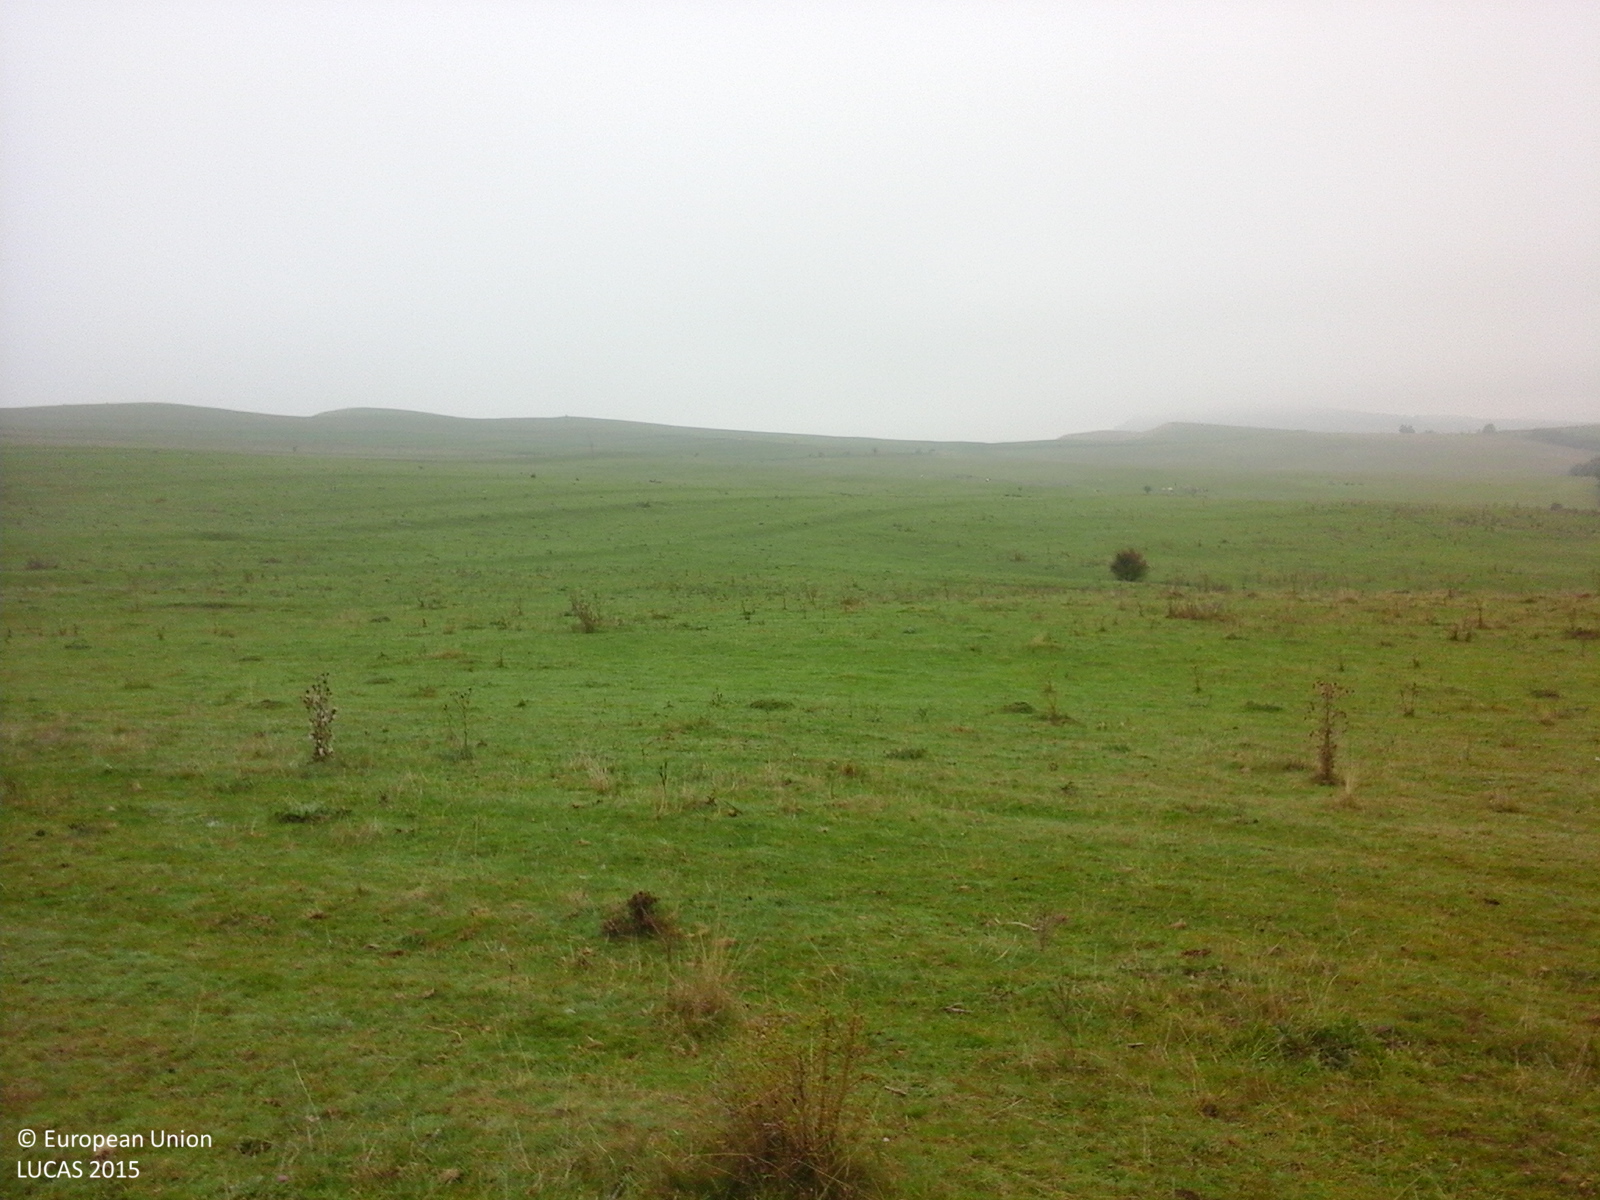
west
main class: Grassland
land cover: Grassland with sparse tree/shrub cover
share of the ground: > 75 %
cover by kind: herbaceous plants 95 %, broadleaved forest trees 5 %
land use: Agriculture (excluding fallow land and kitchen gardens)
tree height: < 5 m
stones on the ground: < 10 %
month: October
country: RO
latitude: 46.6723
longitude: 24.3726
